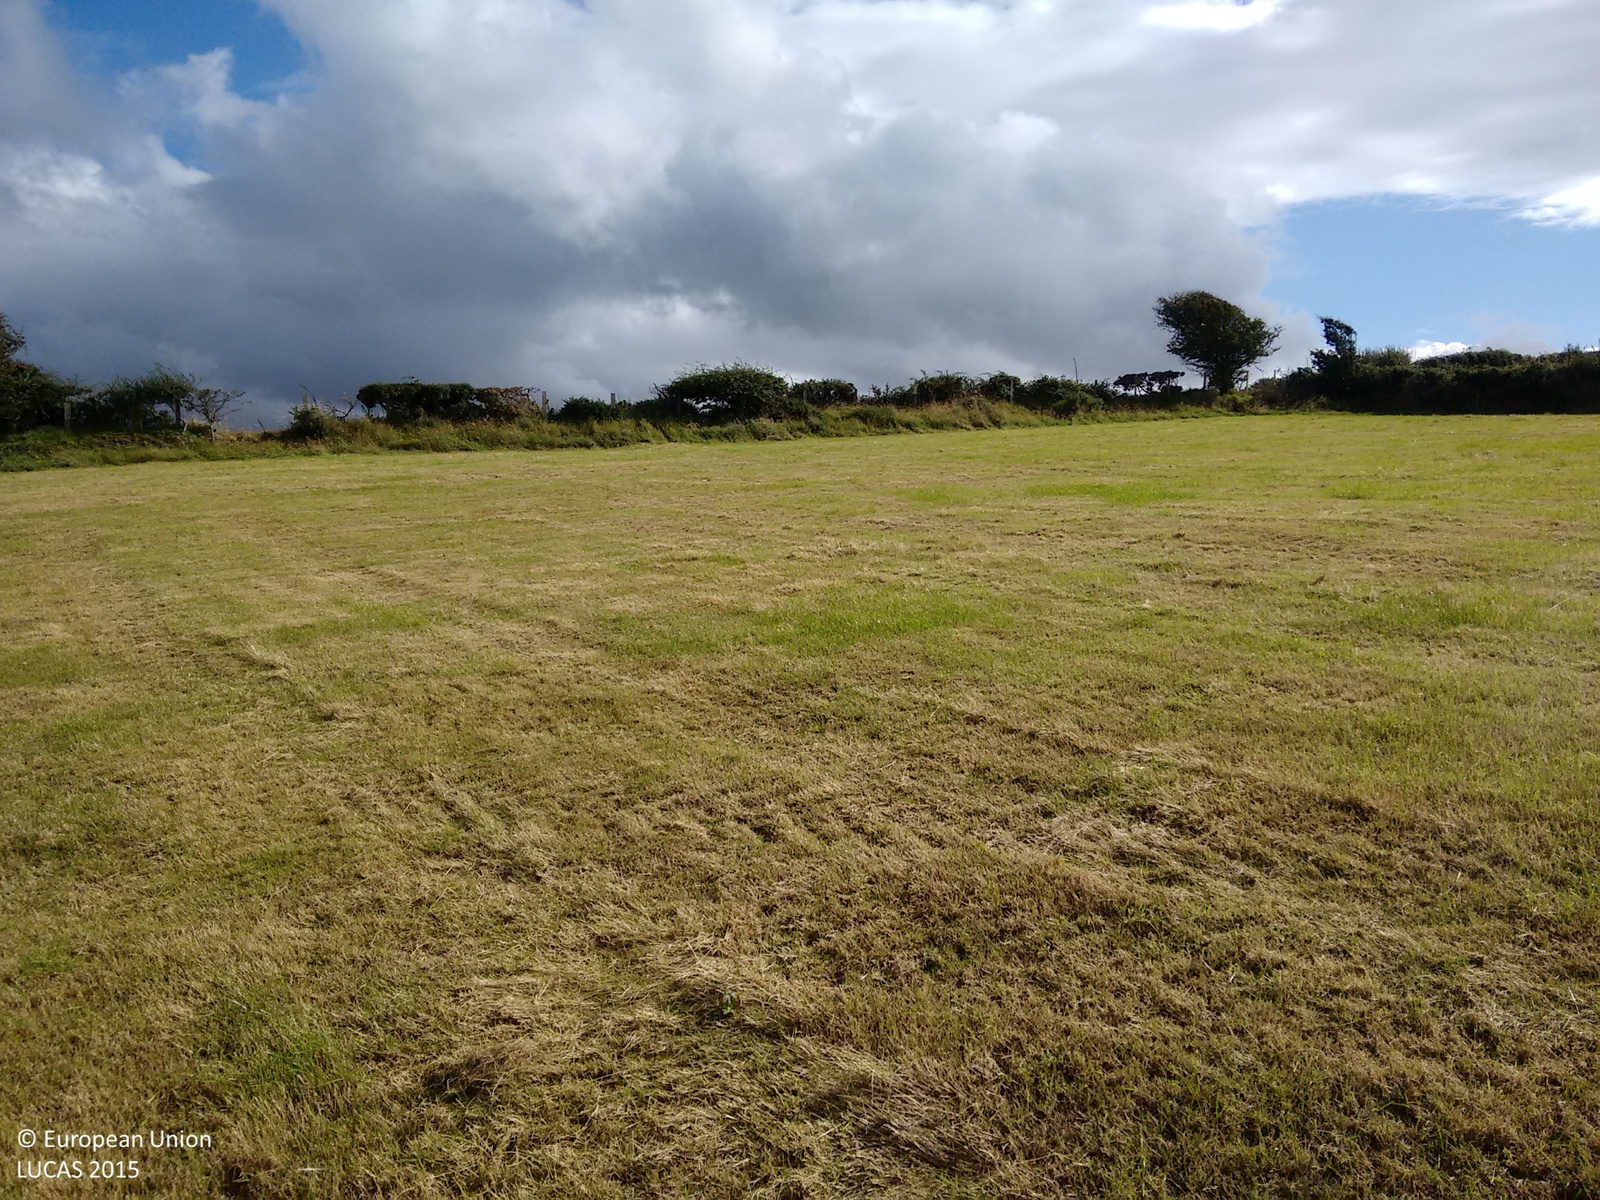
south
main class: Grassland
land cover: Grassland without tree/shrub cover
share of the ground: > 75 %
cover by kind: herbaceous plants 75 %, consolidated bare surface 25 %
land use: Agriculture (excluding fallow land and kitchen gardens)
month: August
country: GB
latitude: 52.0928
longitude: -4.7212
